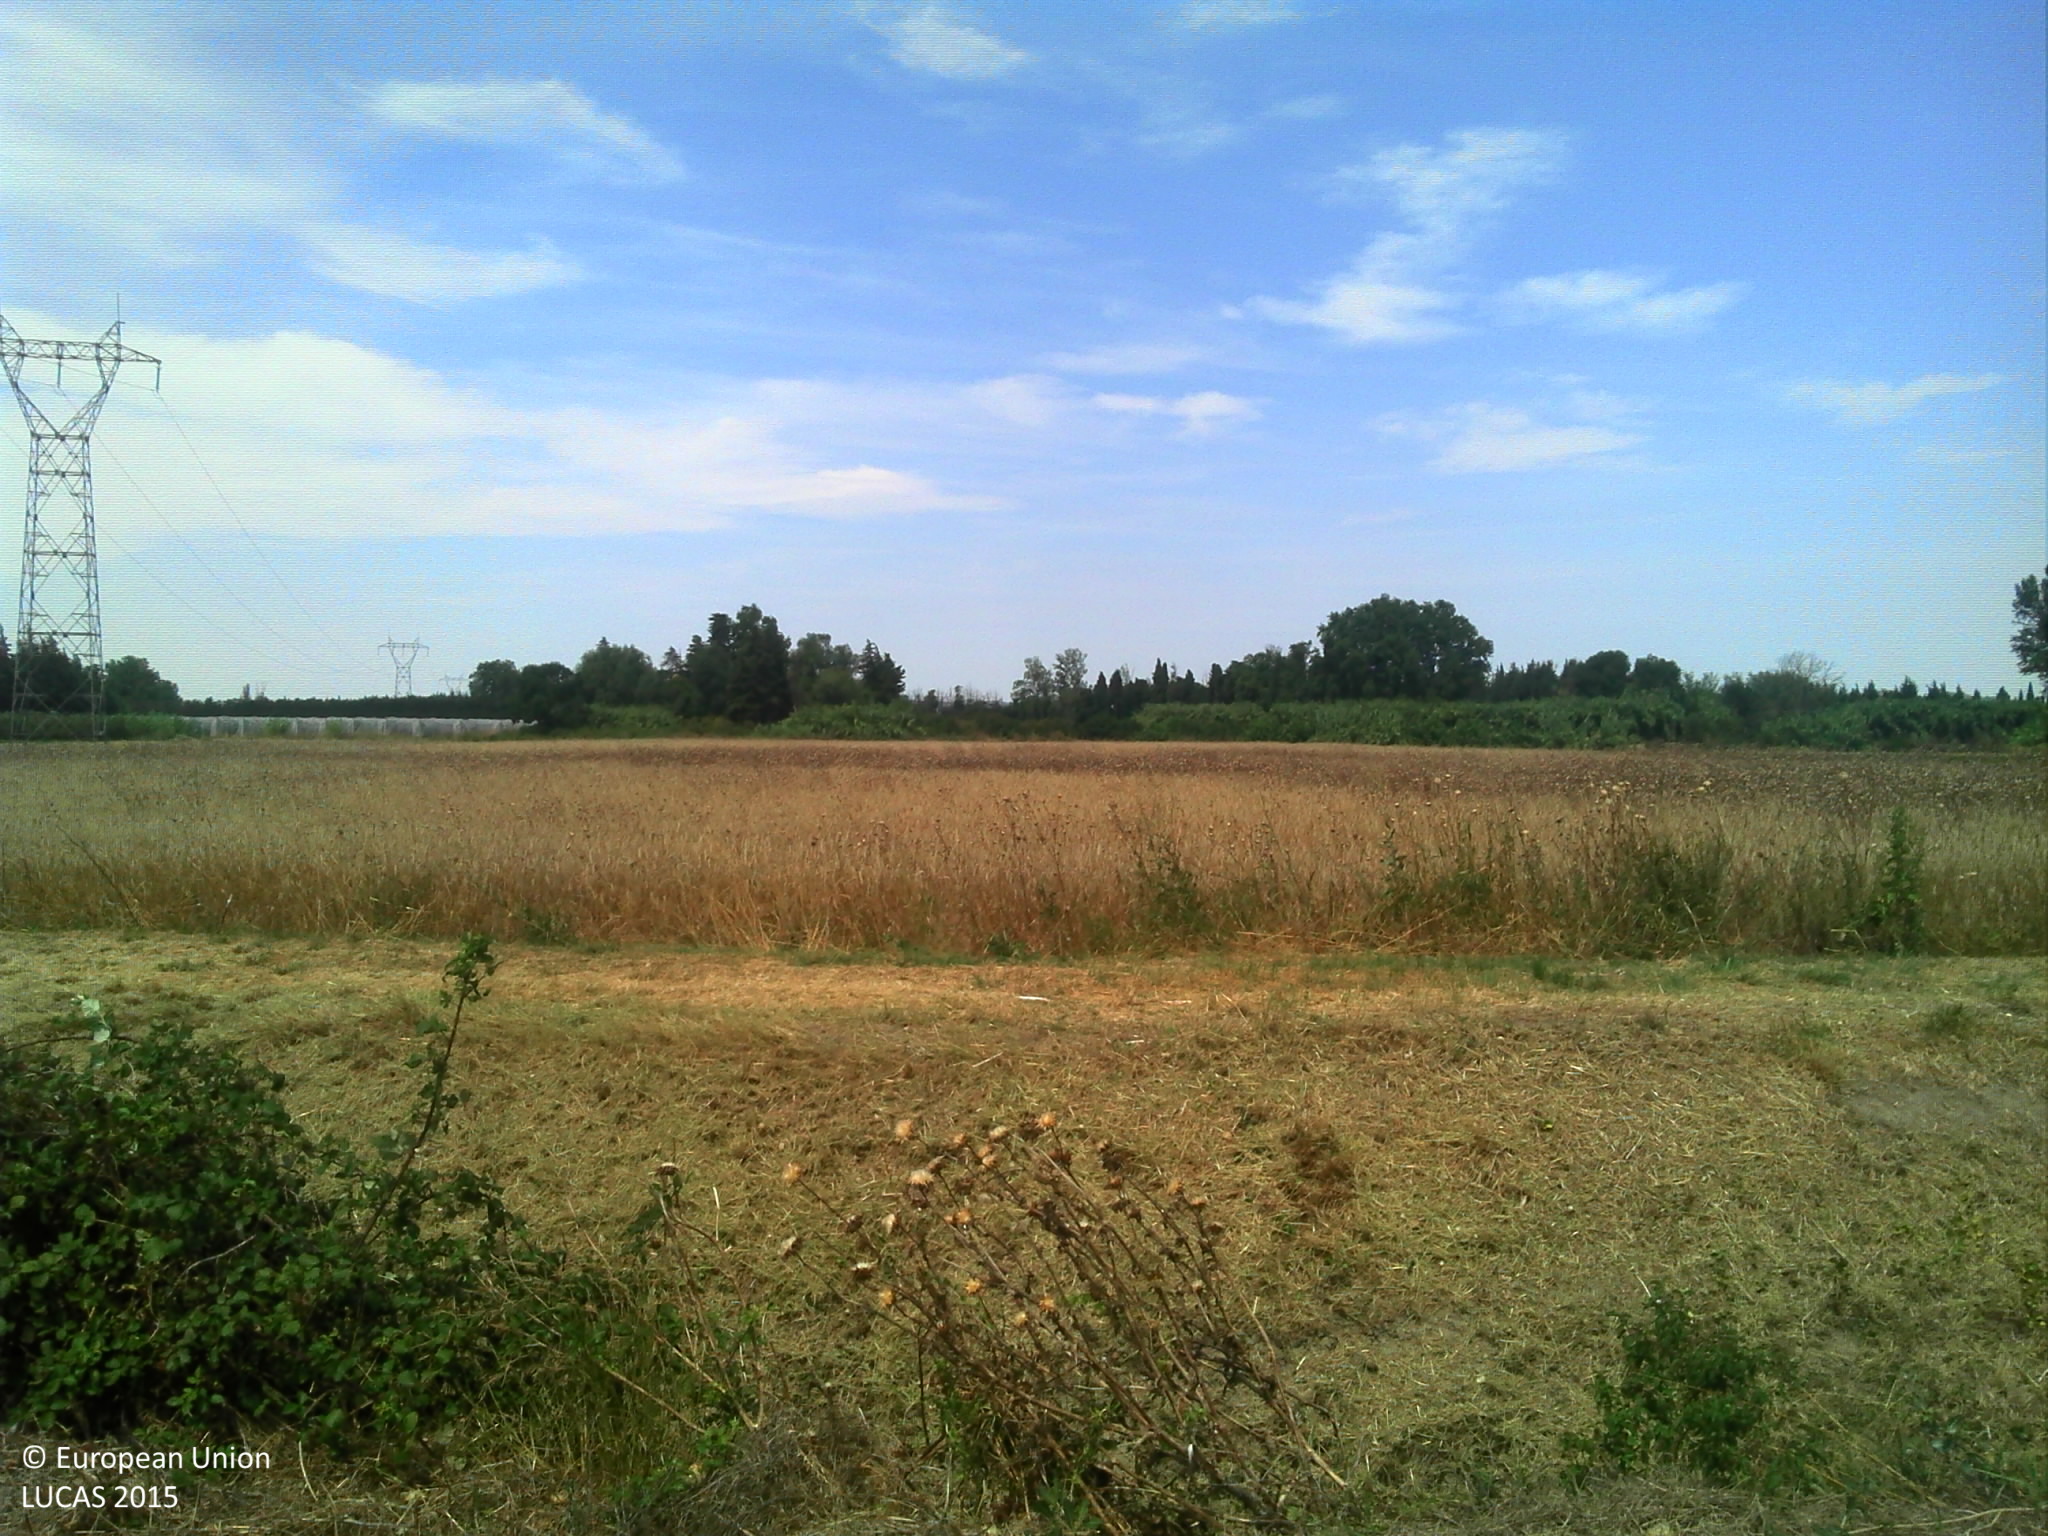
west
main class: Grassland
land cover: Spontaneously vegetated surfaces
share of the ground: 50 - 75 %
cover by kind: herbaceous plants 50 %, unconsolidated bare surface 50 %
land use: Abandoned areas
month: July
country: FR
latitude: 43.8238
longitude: 4.8239
